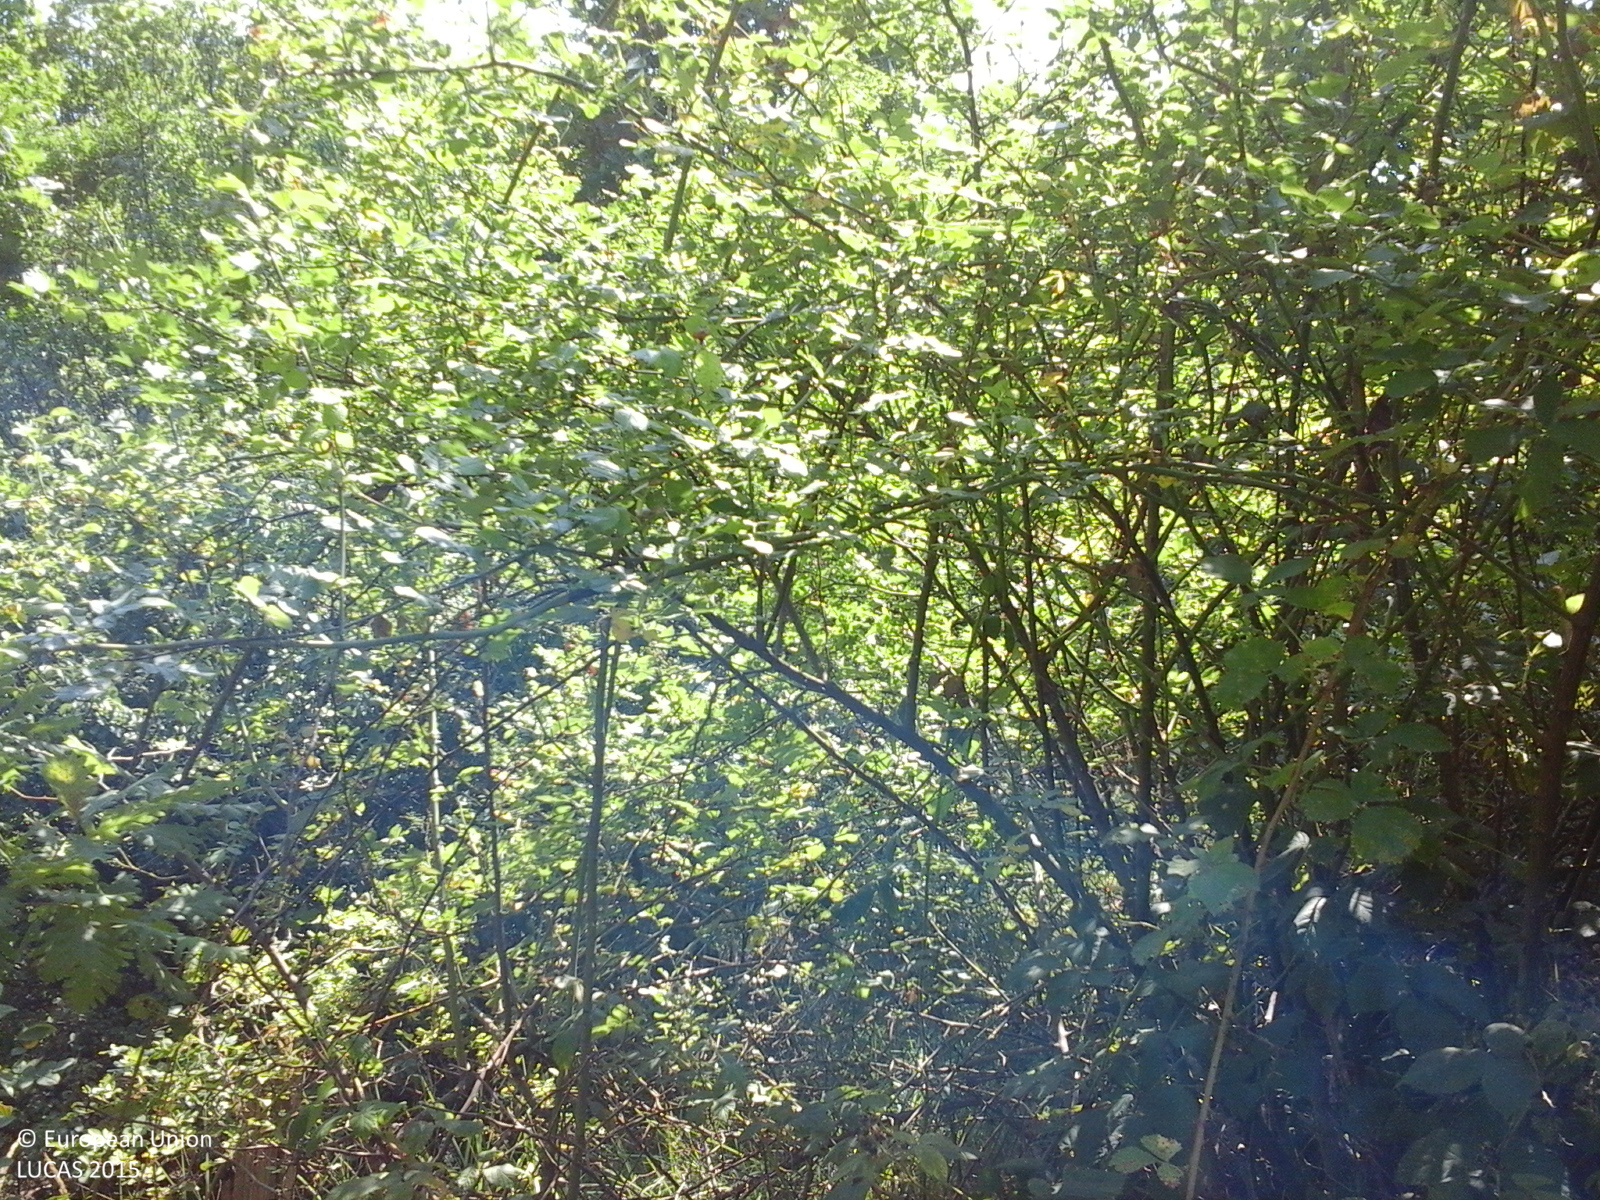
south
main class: Woodland
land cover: Broadleaved woodland
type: acidophilous oak and oak-birch forest
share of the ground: > 75 %
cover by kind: broadleaved forest trees 80 %, shrubs 10 %, herbaceous plants 10 %
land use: Forestry
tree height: > 5 m
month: July
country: RO
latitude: 44.7234
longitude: 24.5811
